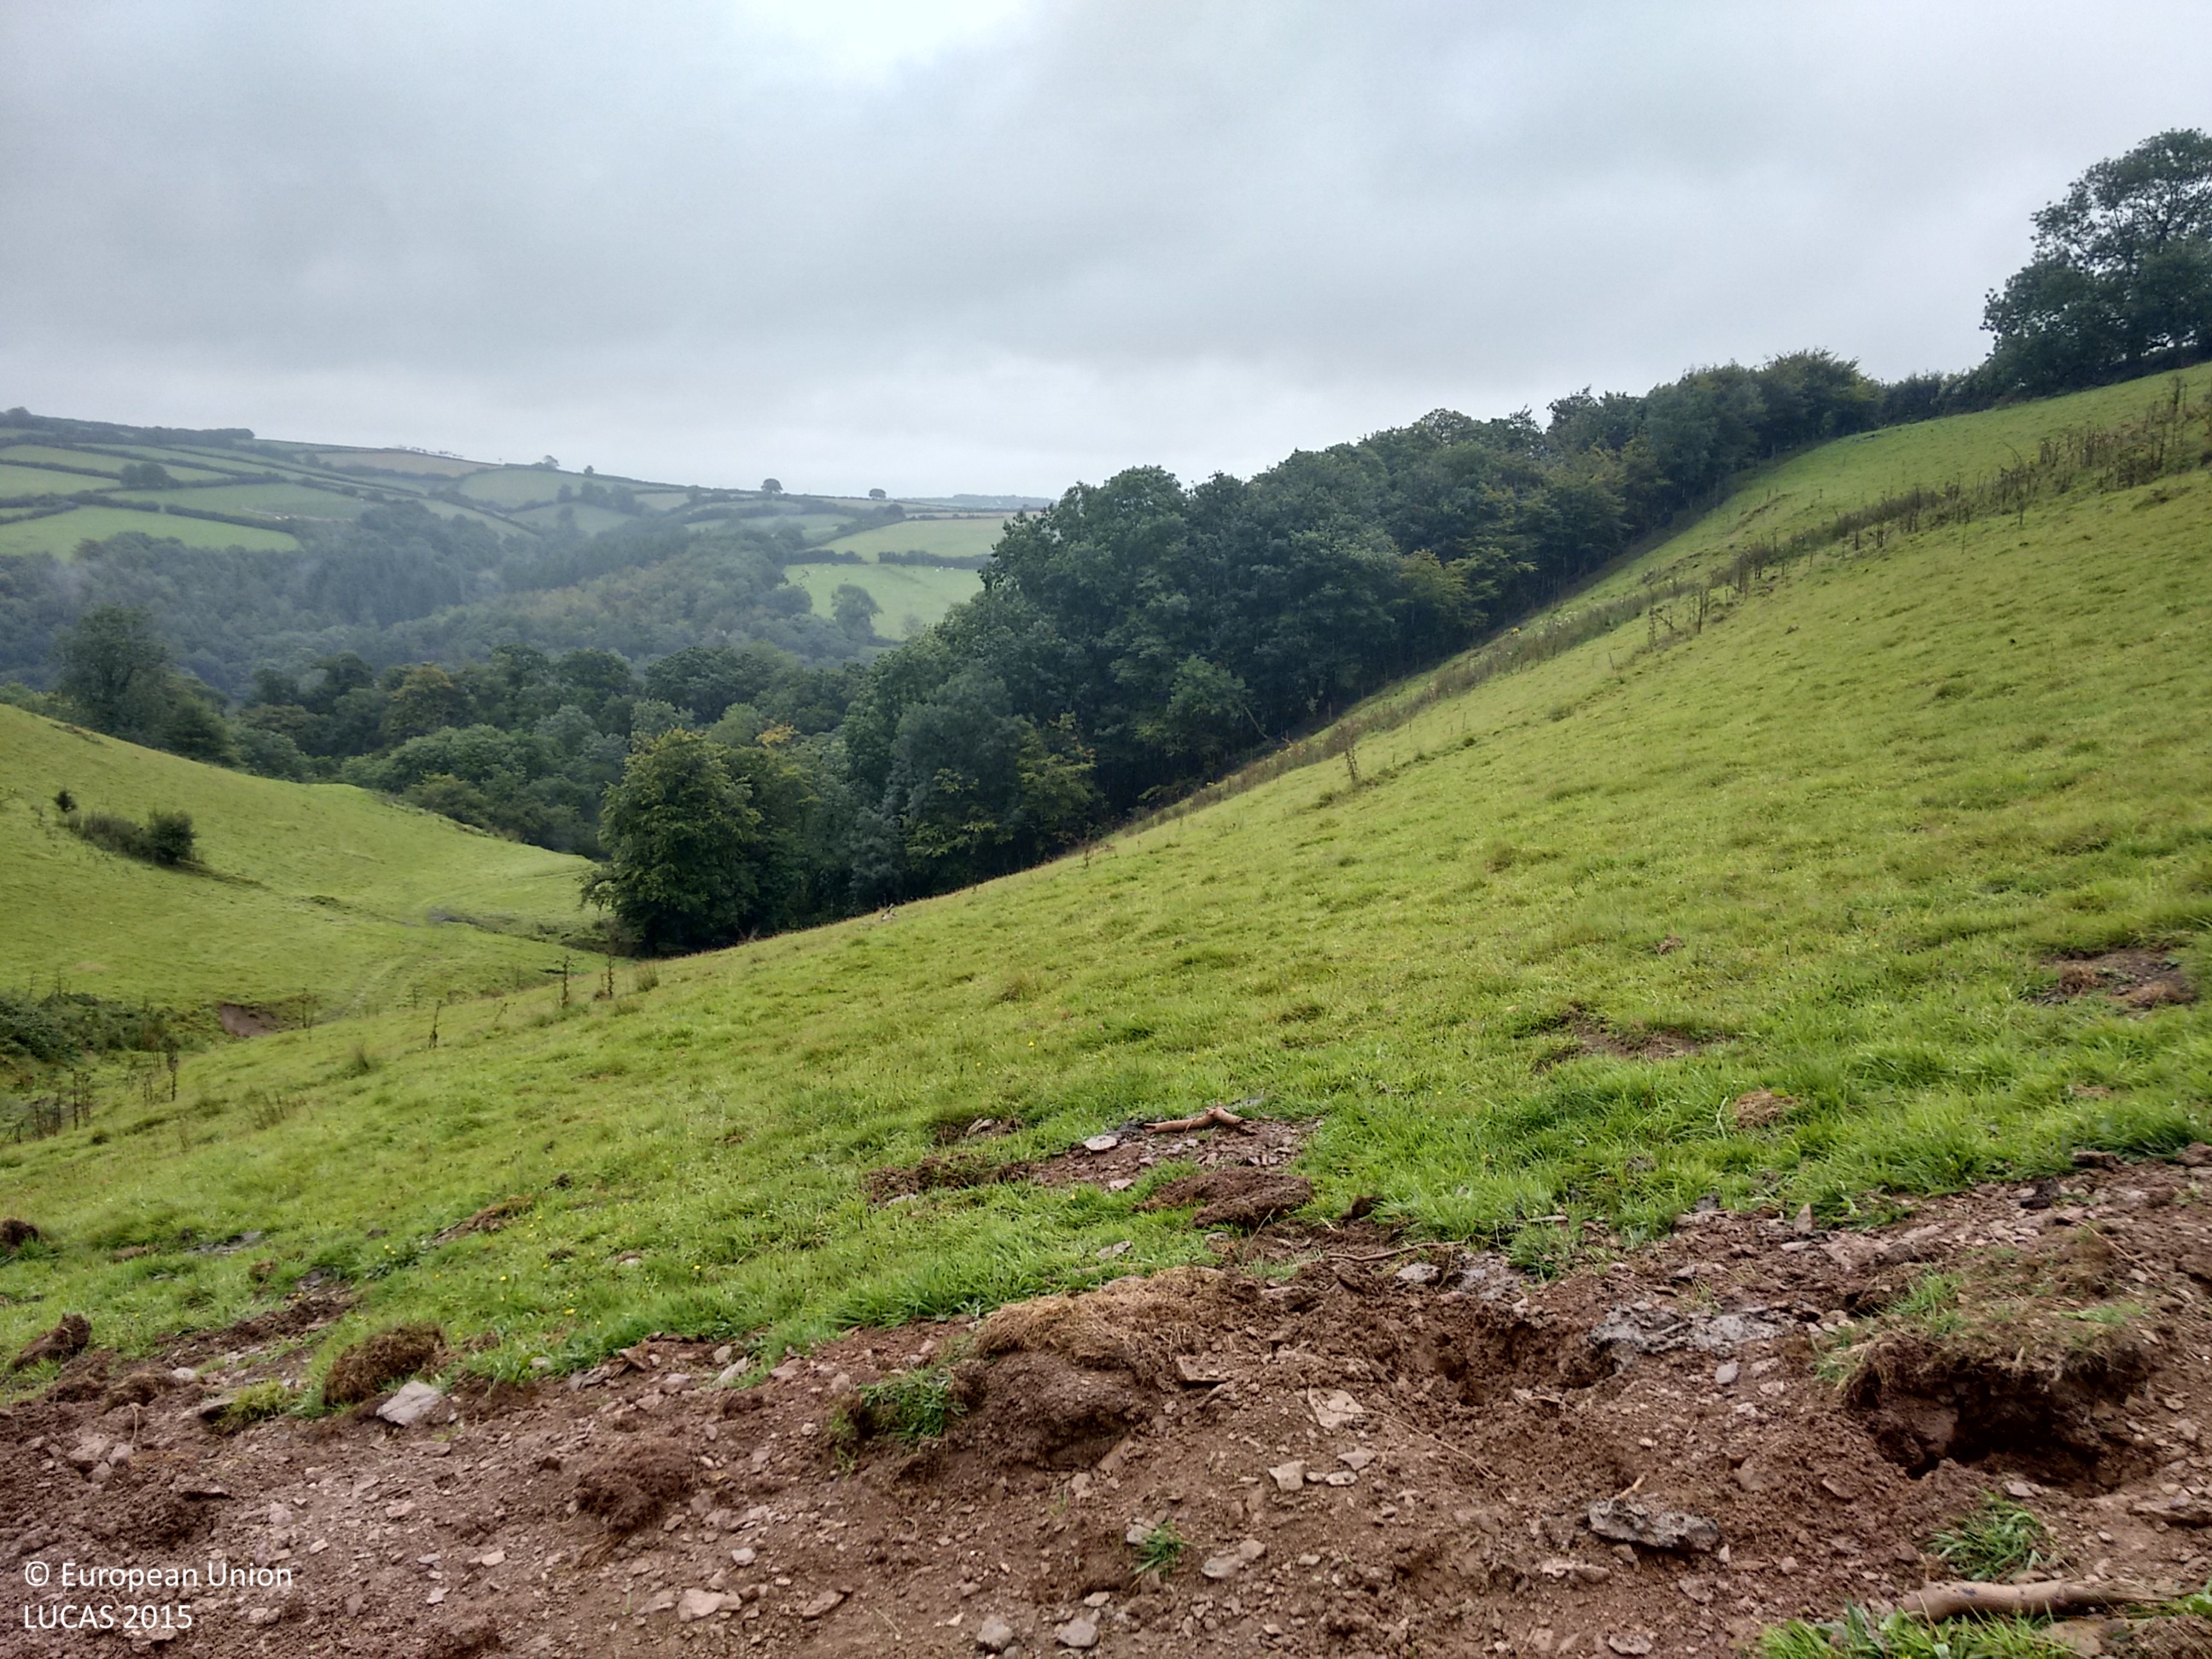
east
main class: Grassland
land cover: Grassland without tree/shrub cover
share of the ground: > 75 %
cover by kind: herbaceous plants 100 %
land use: Agriculture (excluding fallow land and kitchen gardens)
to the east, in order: Grassland without tree/shrub cover; Fences; Broadleaved woodland
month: August
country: GB
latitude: 51.0854
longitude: -3.5474
